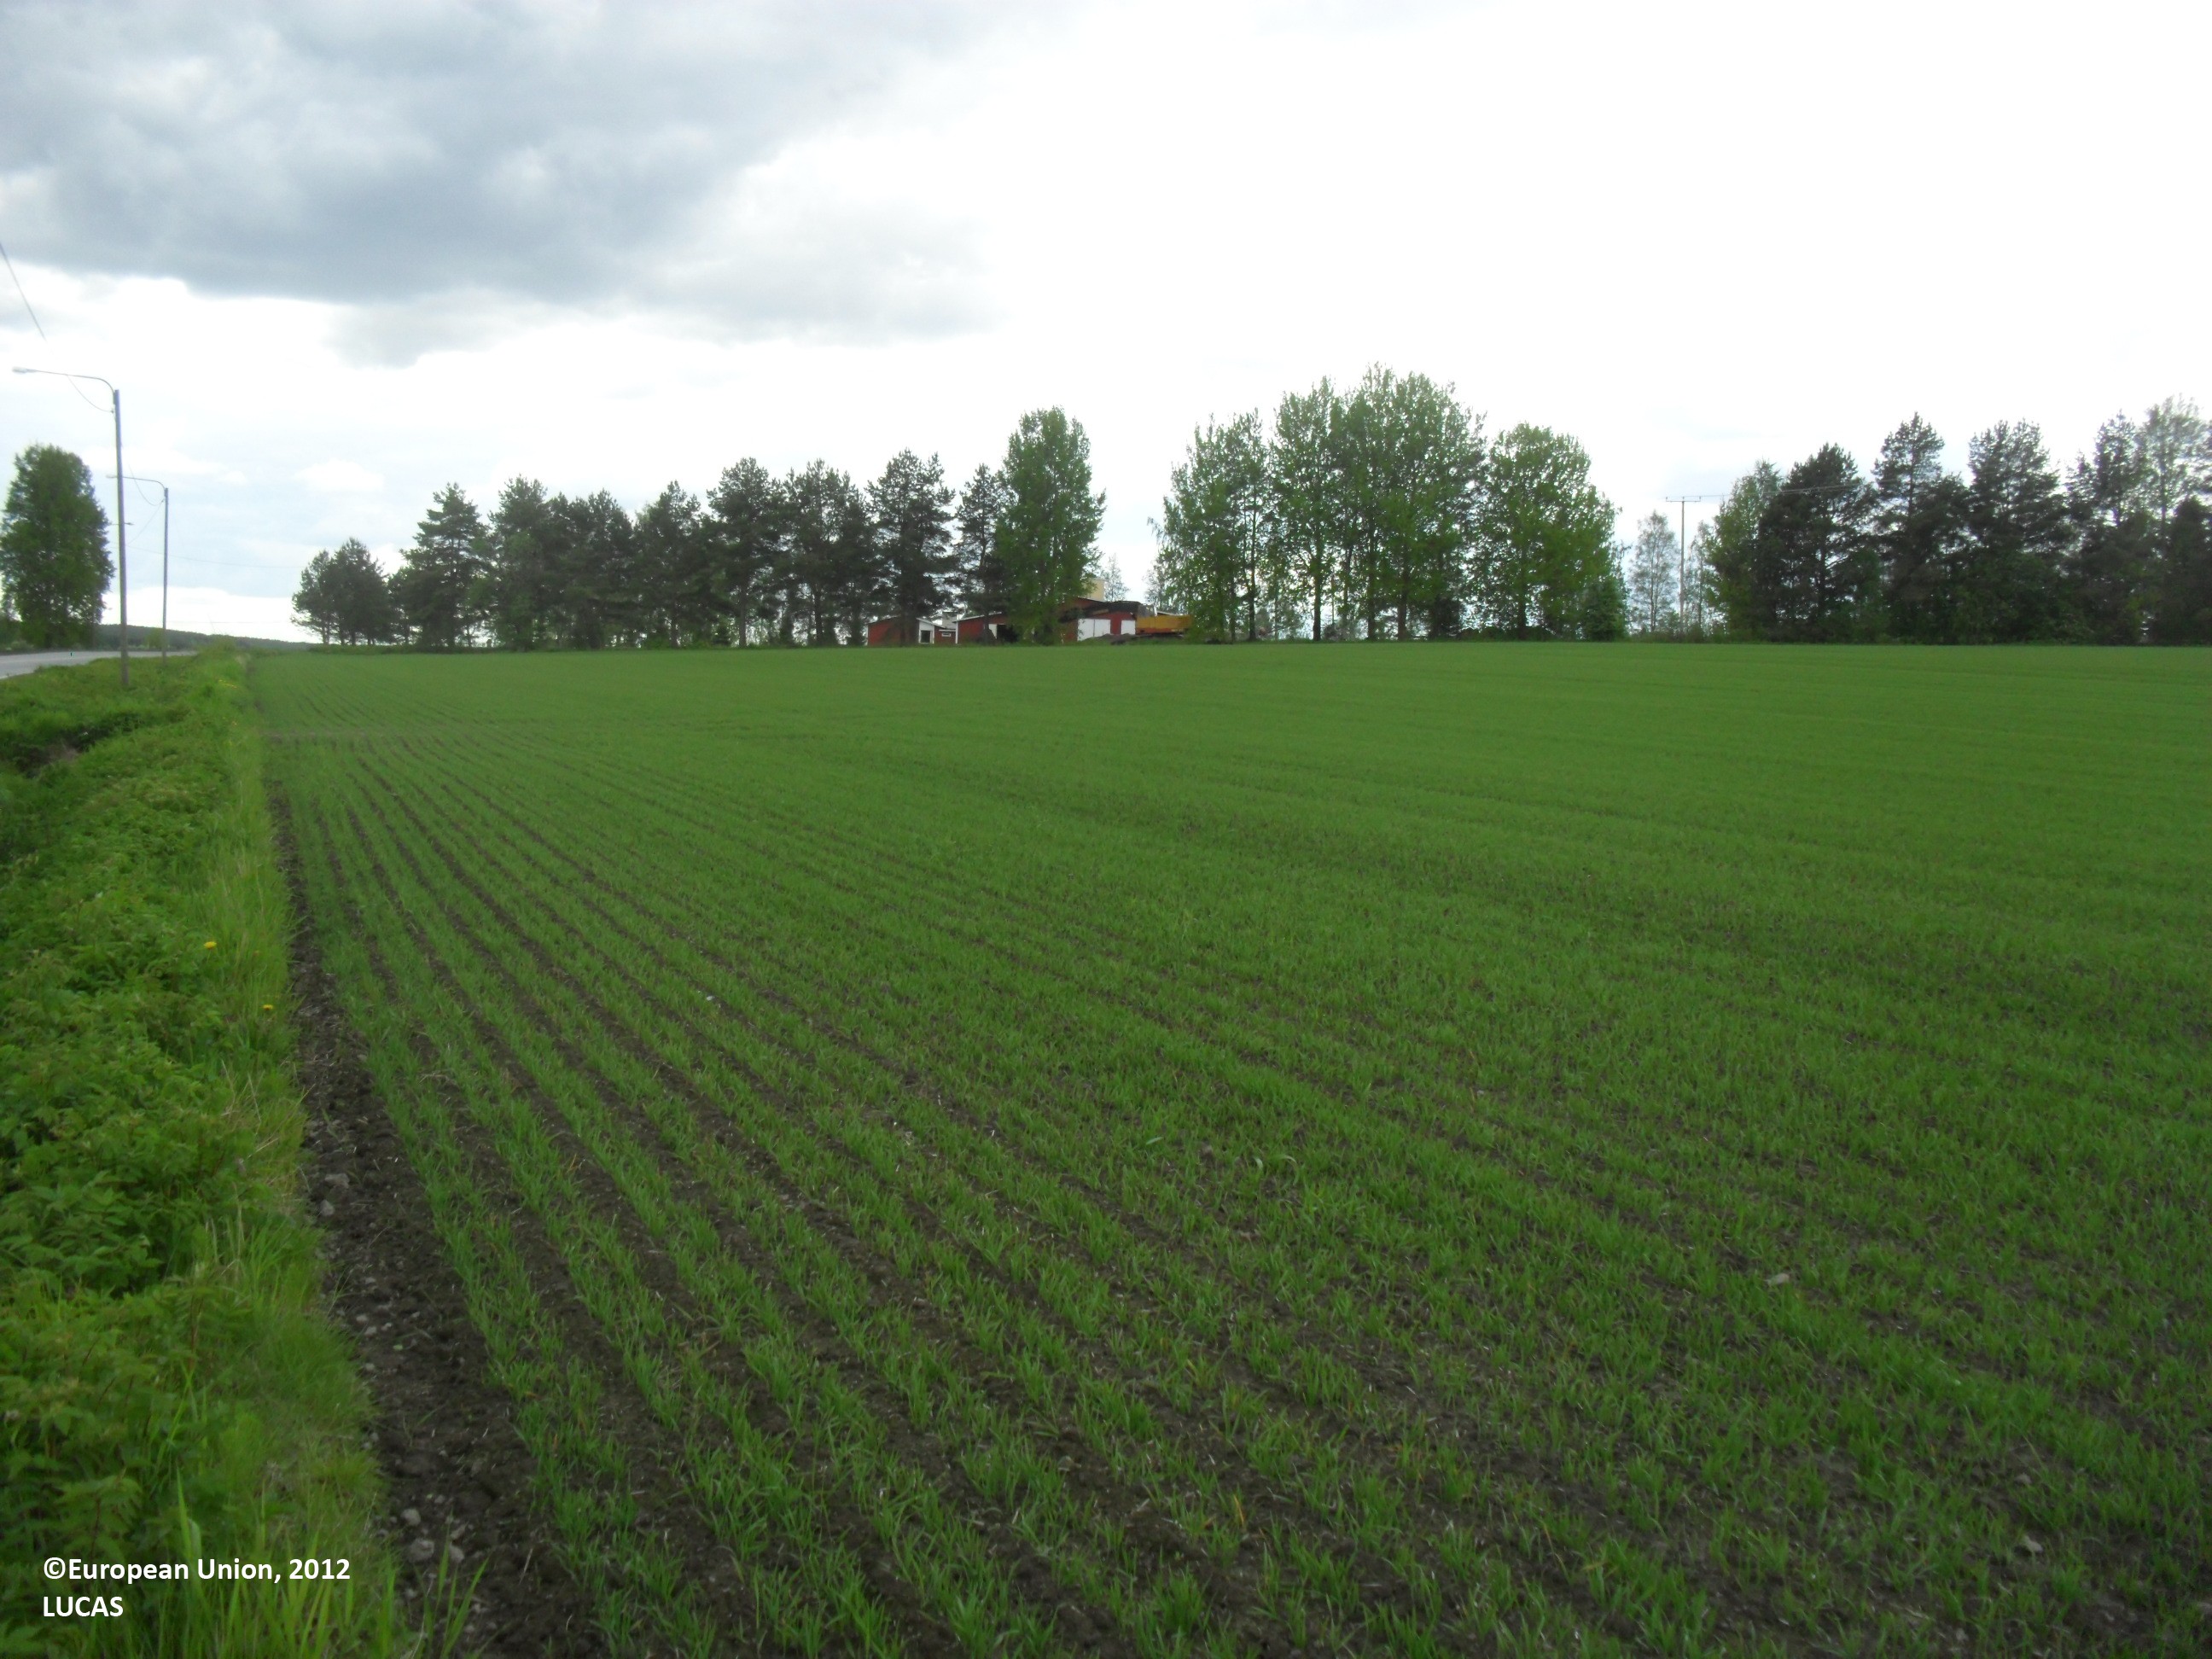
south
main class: Cropland
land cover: Oats
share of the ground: < 10 %
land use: Agriculture (excluding fallow land and kitchen gardens)
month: June
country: FI
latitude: 62.9256
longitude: 22.9980
